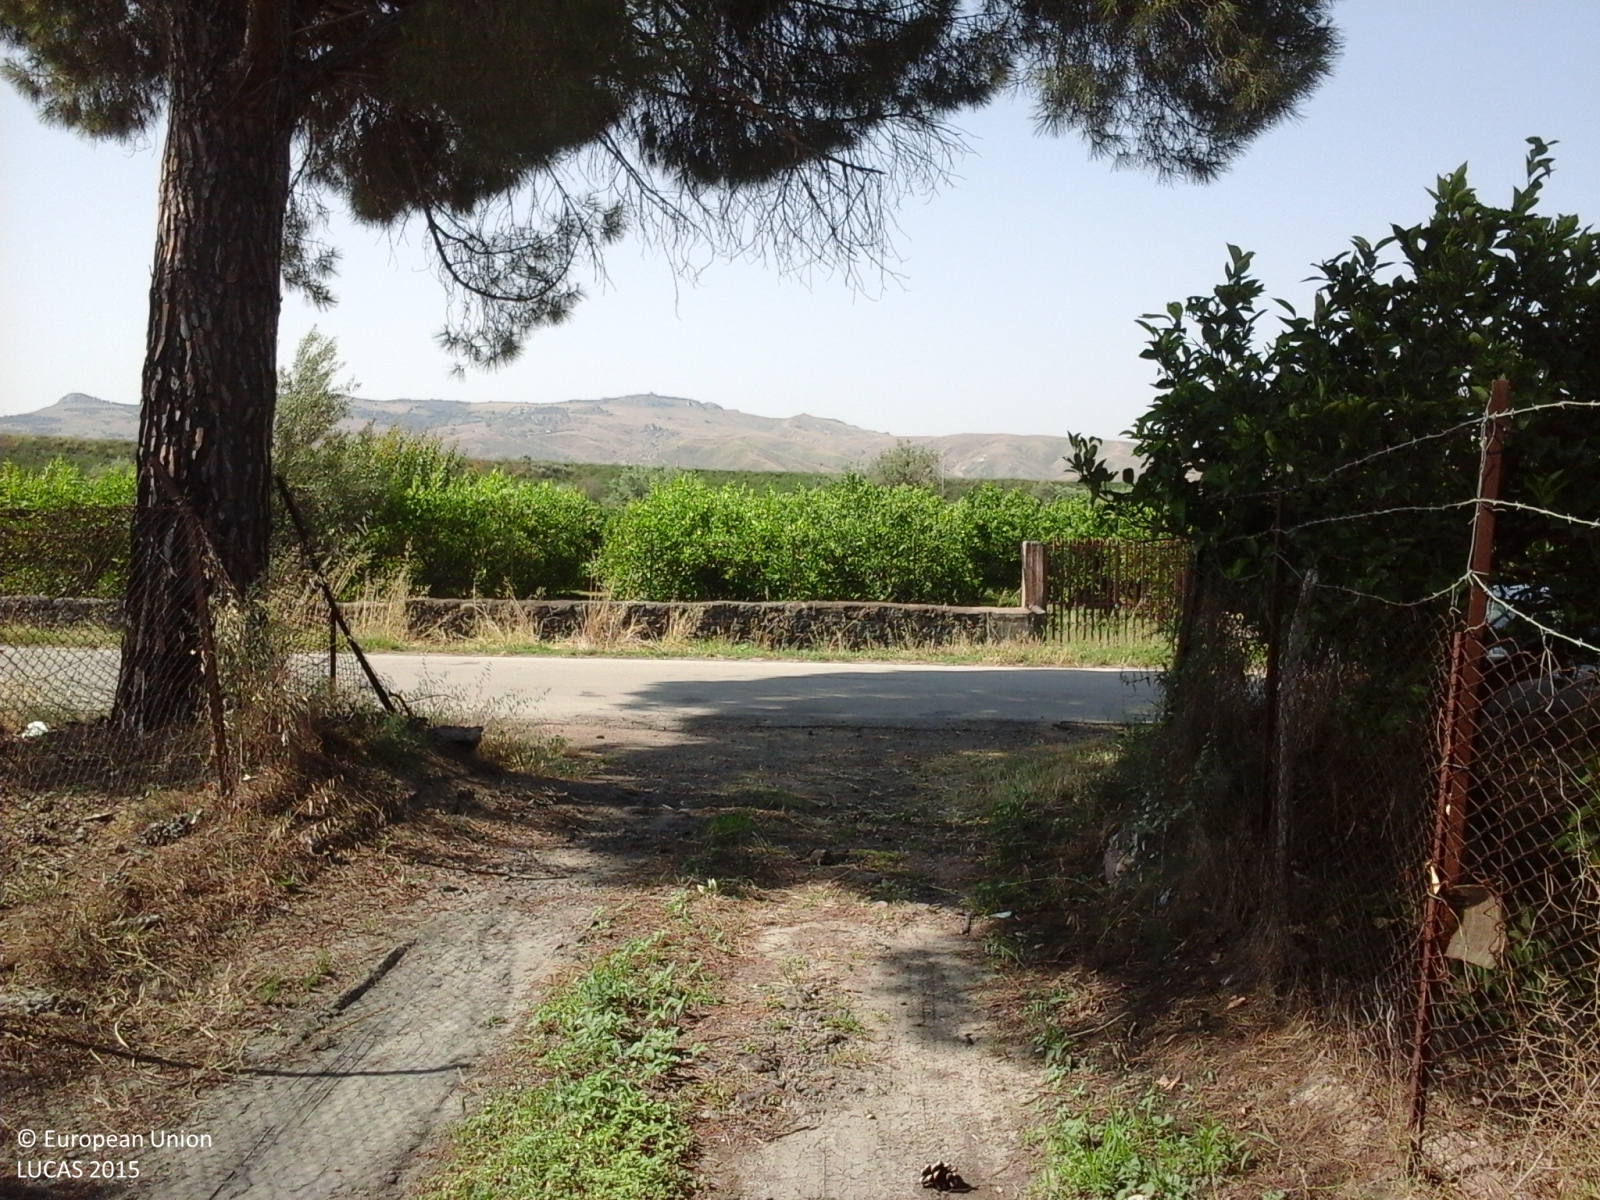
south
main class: Cropland
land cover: Oranges
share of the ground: > 75 %
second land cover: Spontaneously vegetated surfaces
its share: > 75 %
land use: Agriculture (excluding fallow land and kitchen gardens)
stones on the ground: 10 - 25 %
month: June
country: IT
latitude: 37.6069
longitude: 14.8251
